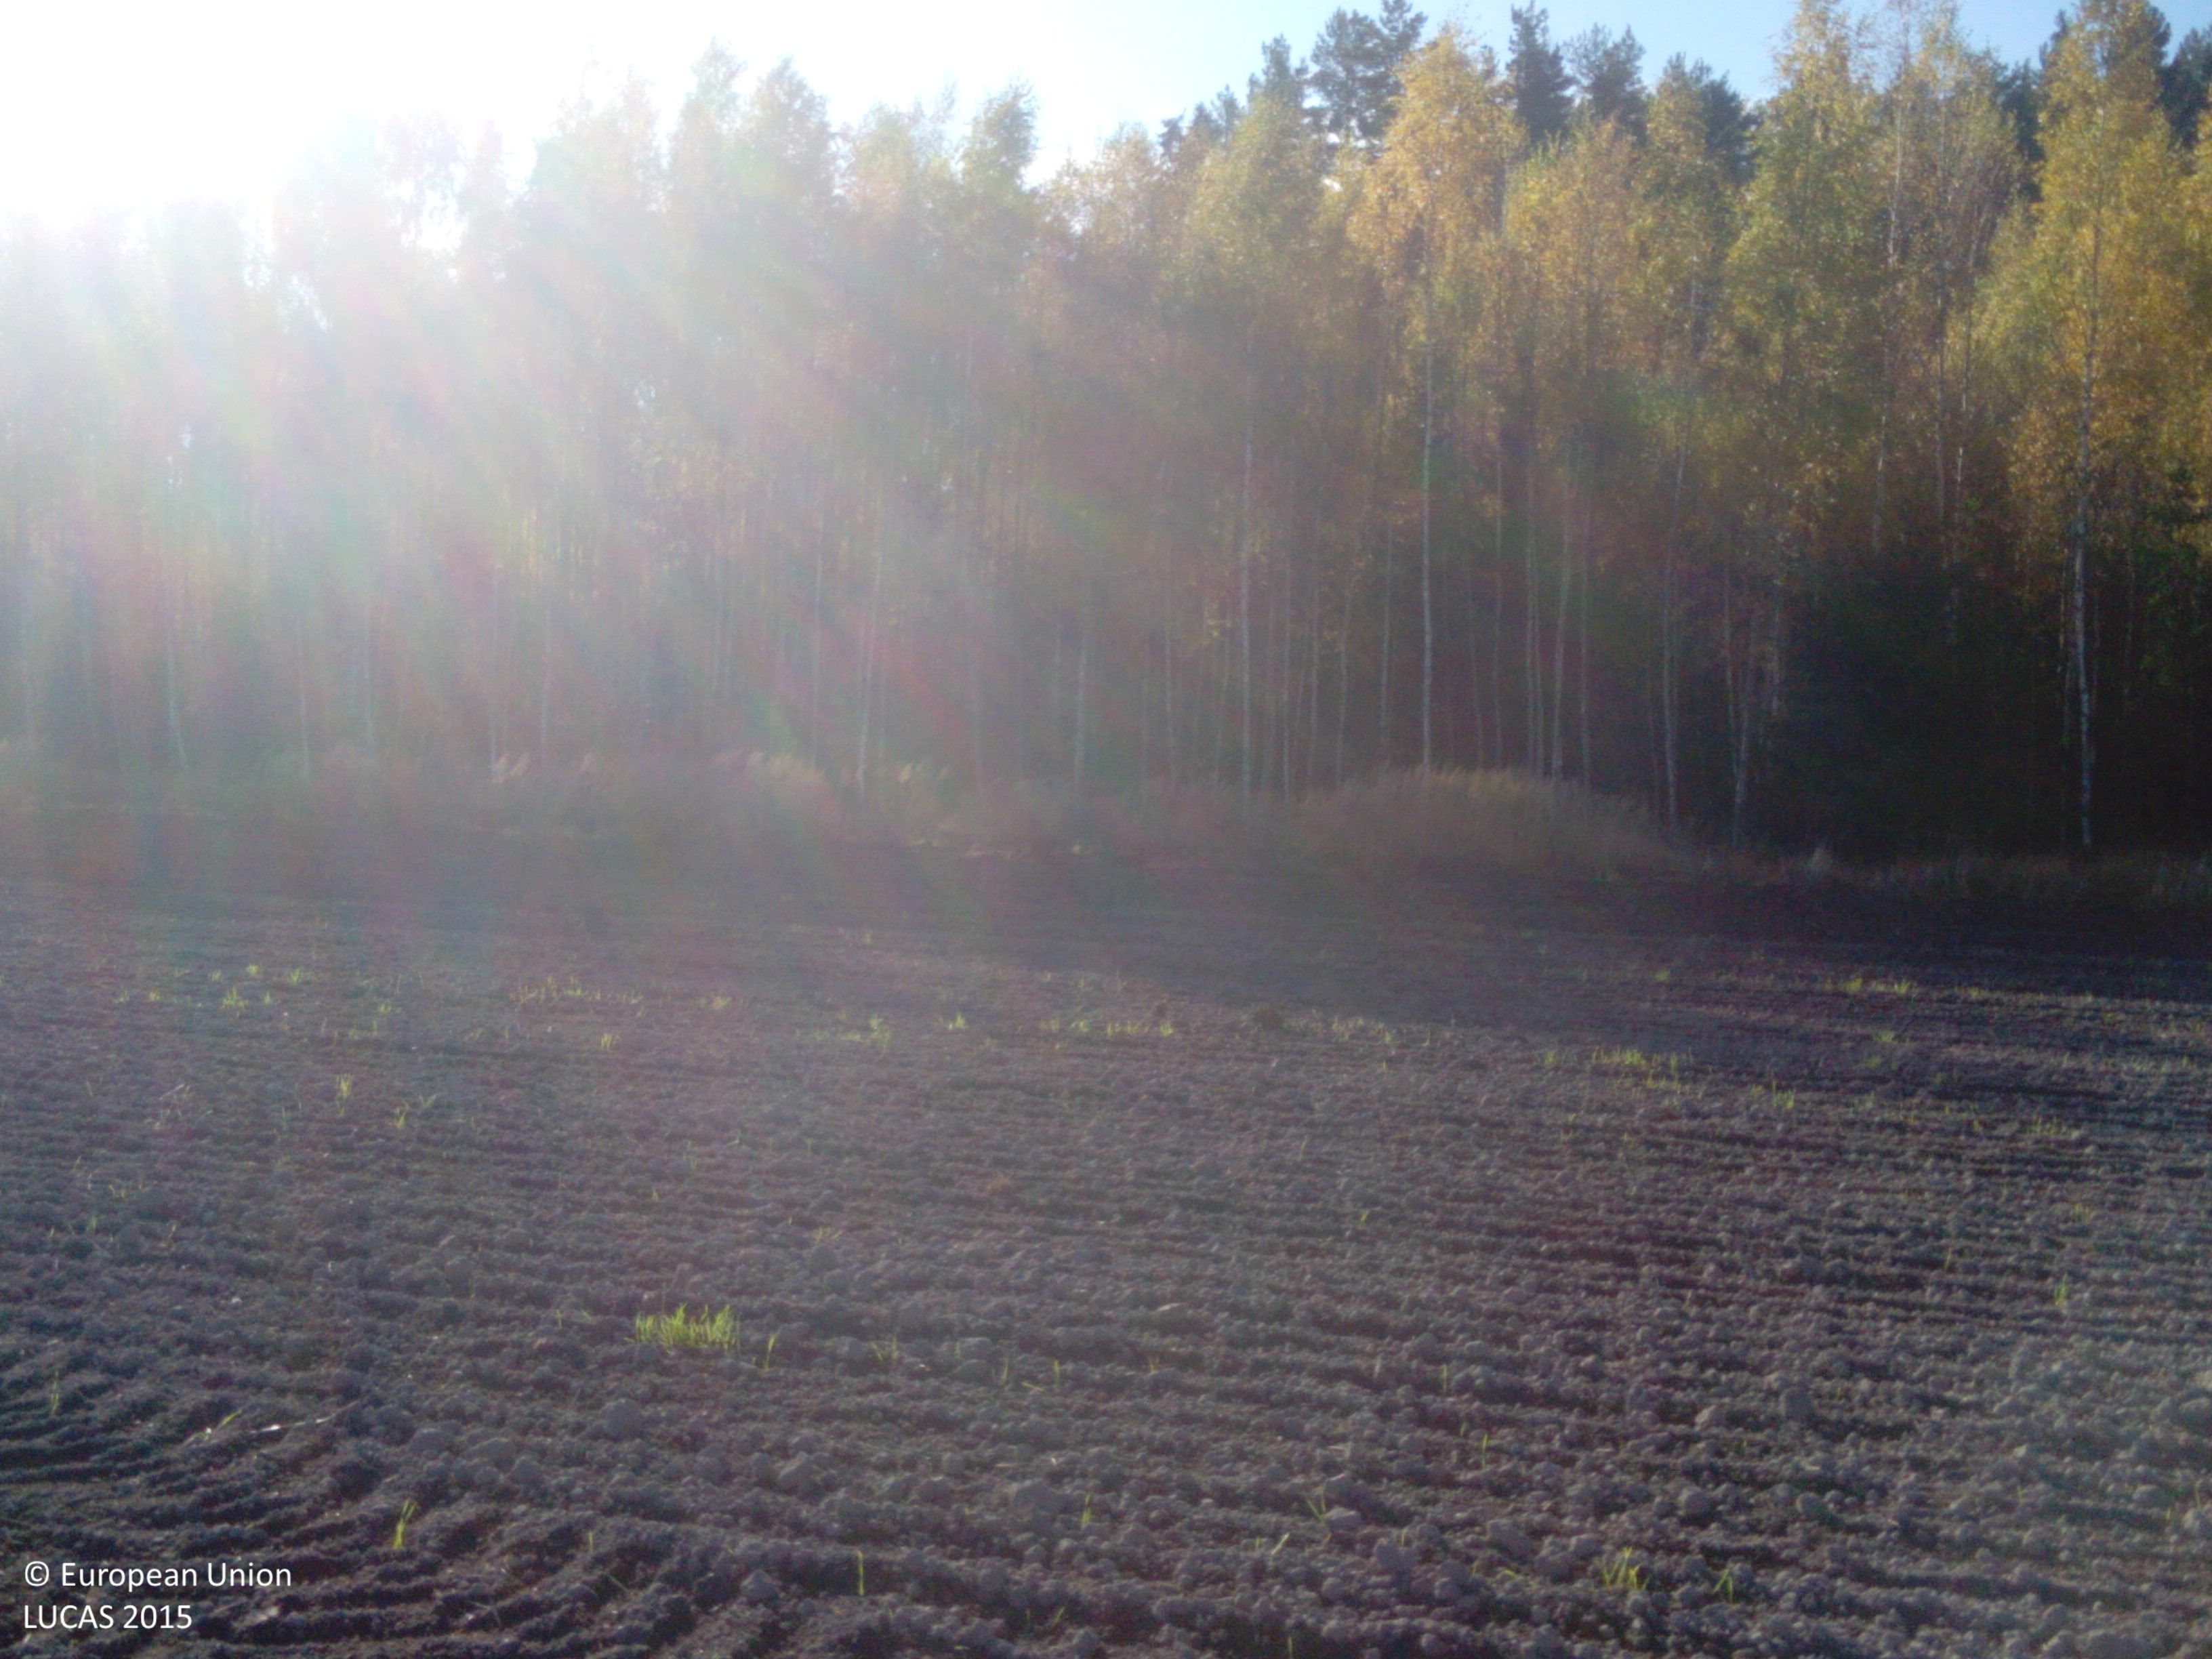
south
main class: Cropland
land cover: Common wheat
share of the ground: < 10 %
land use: Agriculture (excluding fallow land and kitchen gardens)
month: October
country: SE
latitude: 58.9106
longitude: 16.5056
